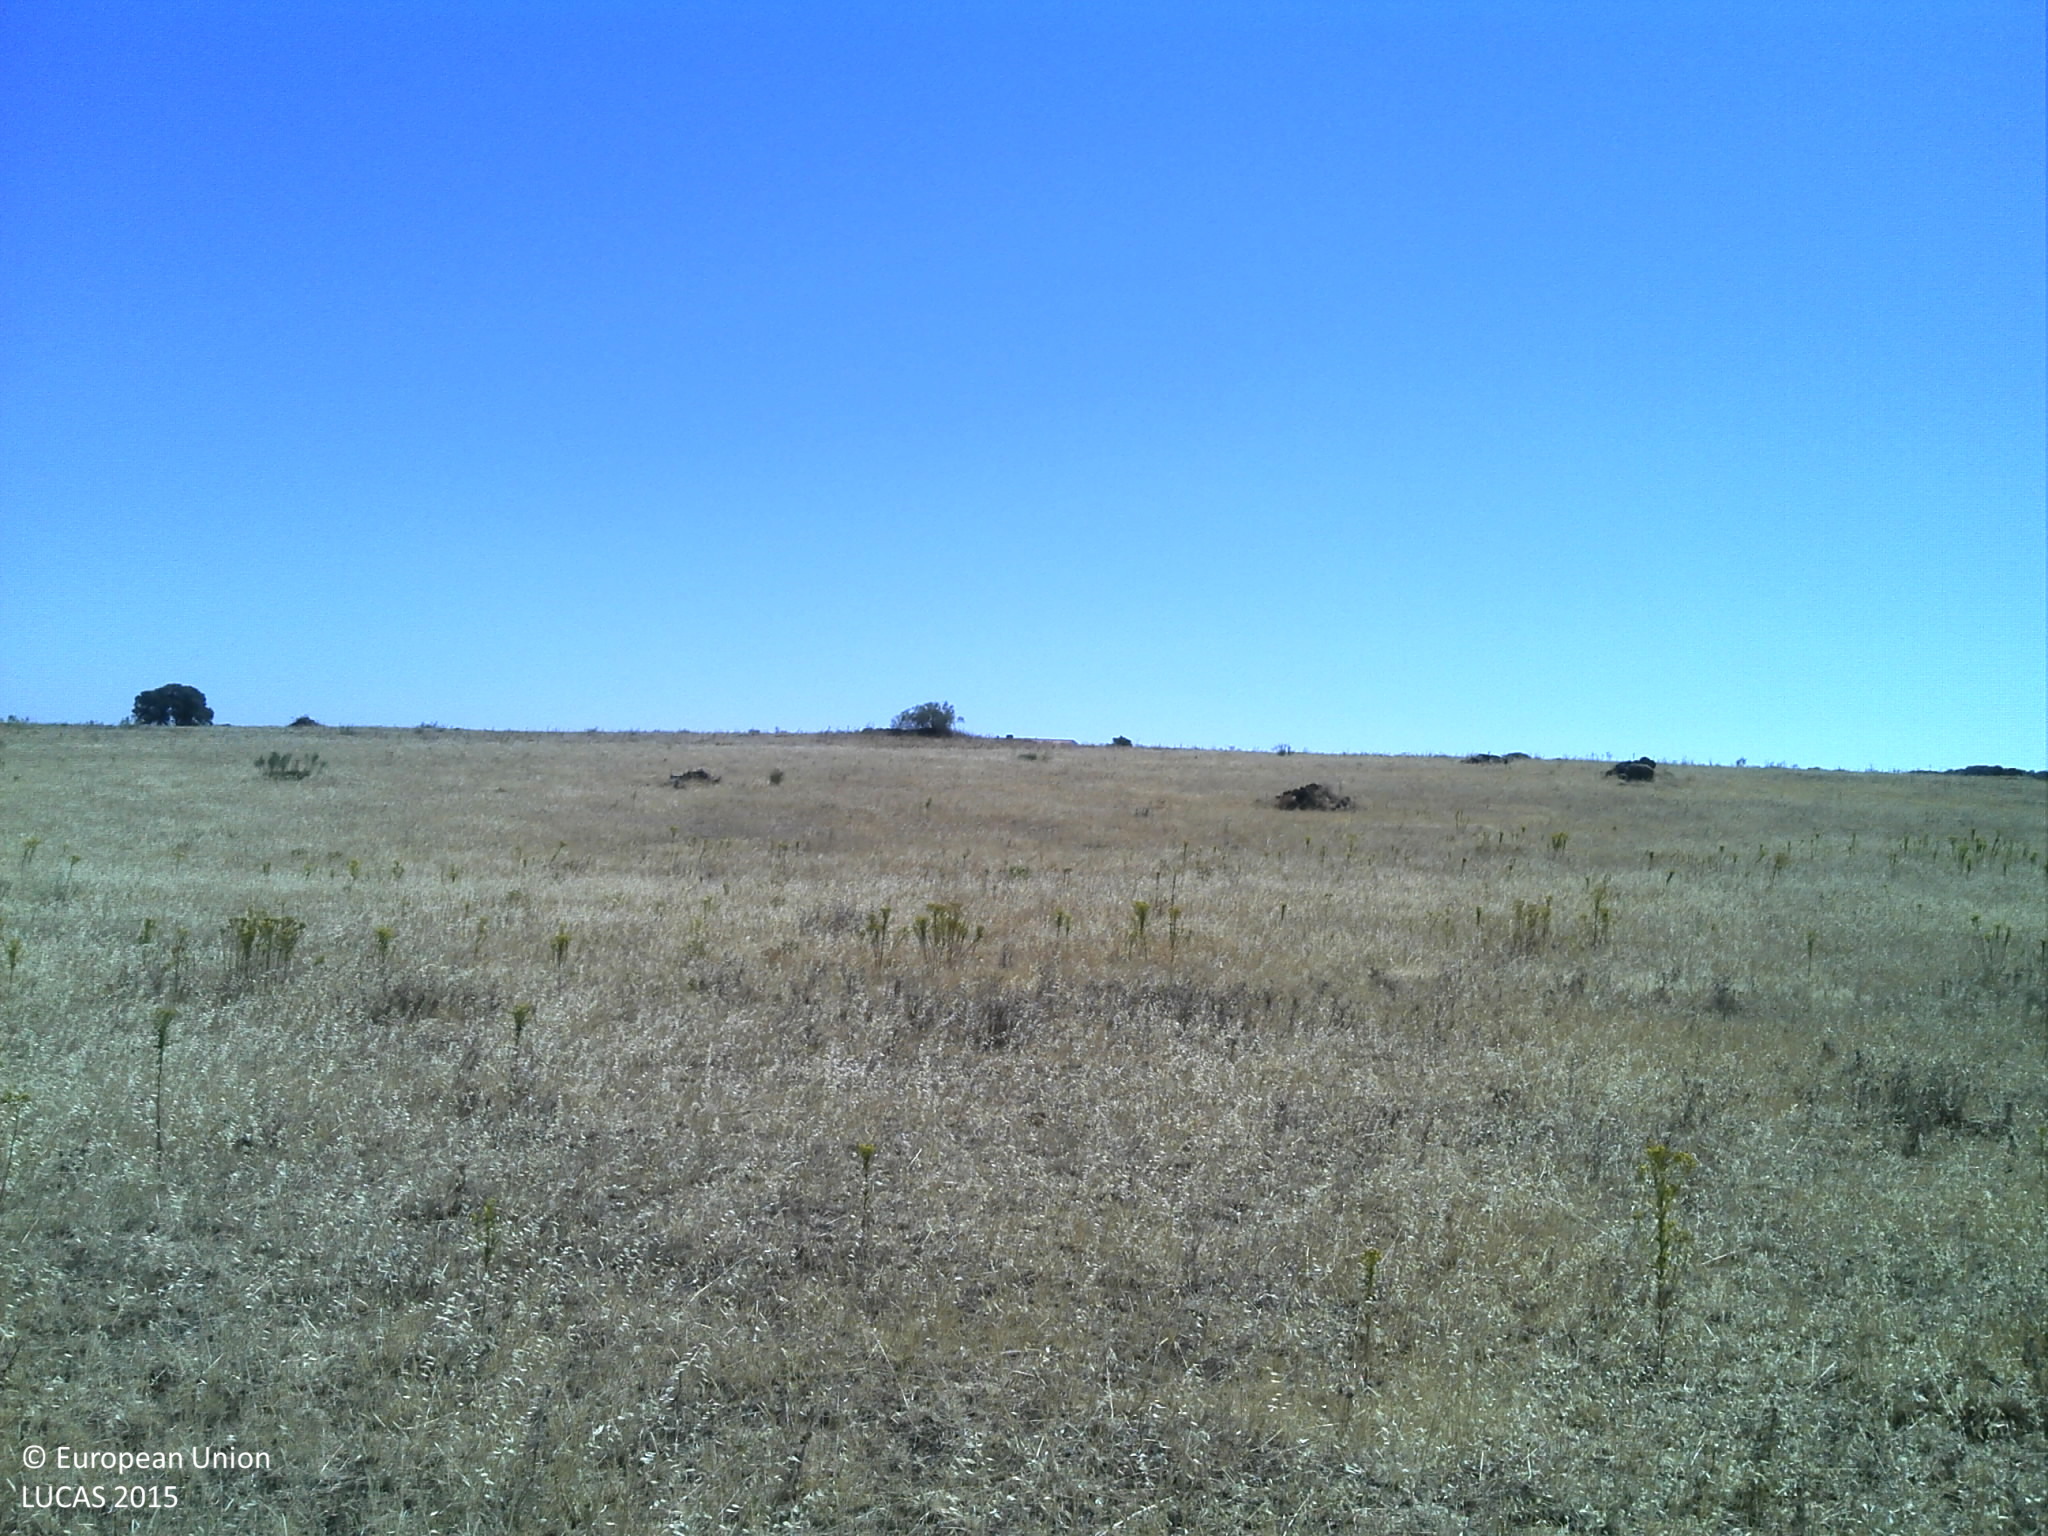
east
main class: Grassland
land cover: Grassland without tree/shrub cover
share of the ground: 10 - 25 %
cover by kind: unconsolidated bare surface 85 %, herbaceous plants 15 %
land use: Agriculture (excluding fallow land and kitchen gardens)
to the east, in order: Grassland without tree/shrub cover; Rock outcrops; Grassland without tree/shrub cover
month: July
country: PT
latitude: 38.9600
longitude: -7.2847
